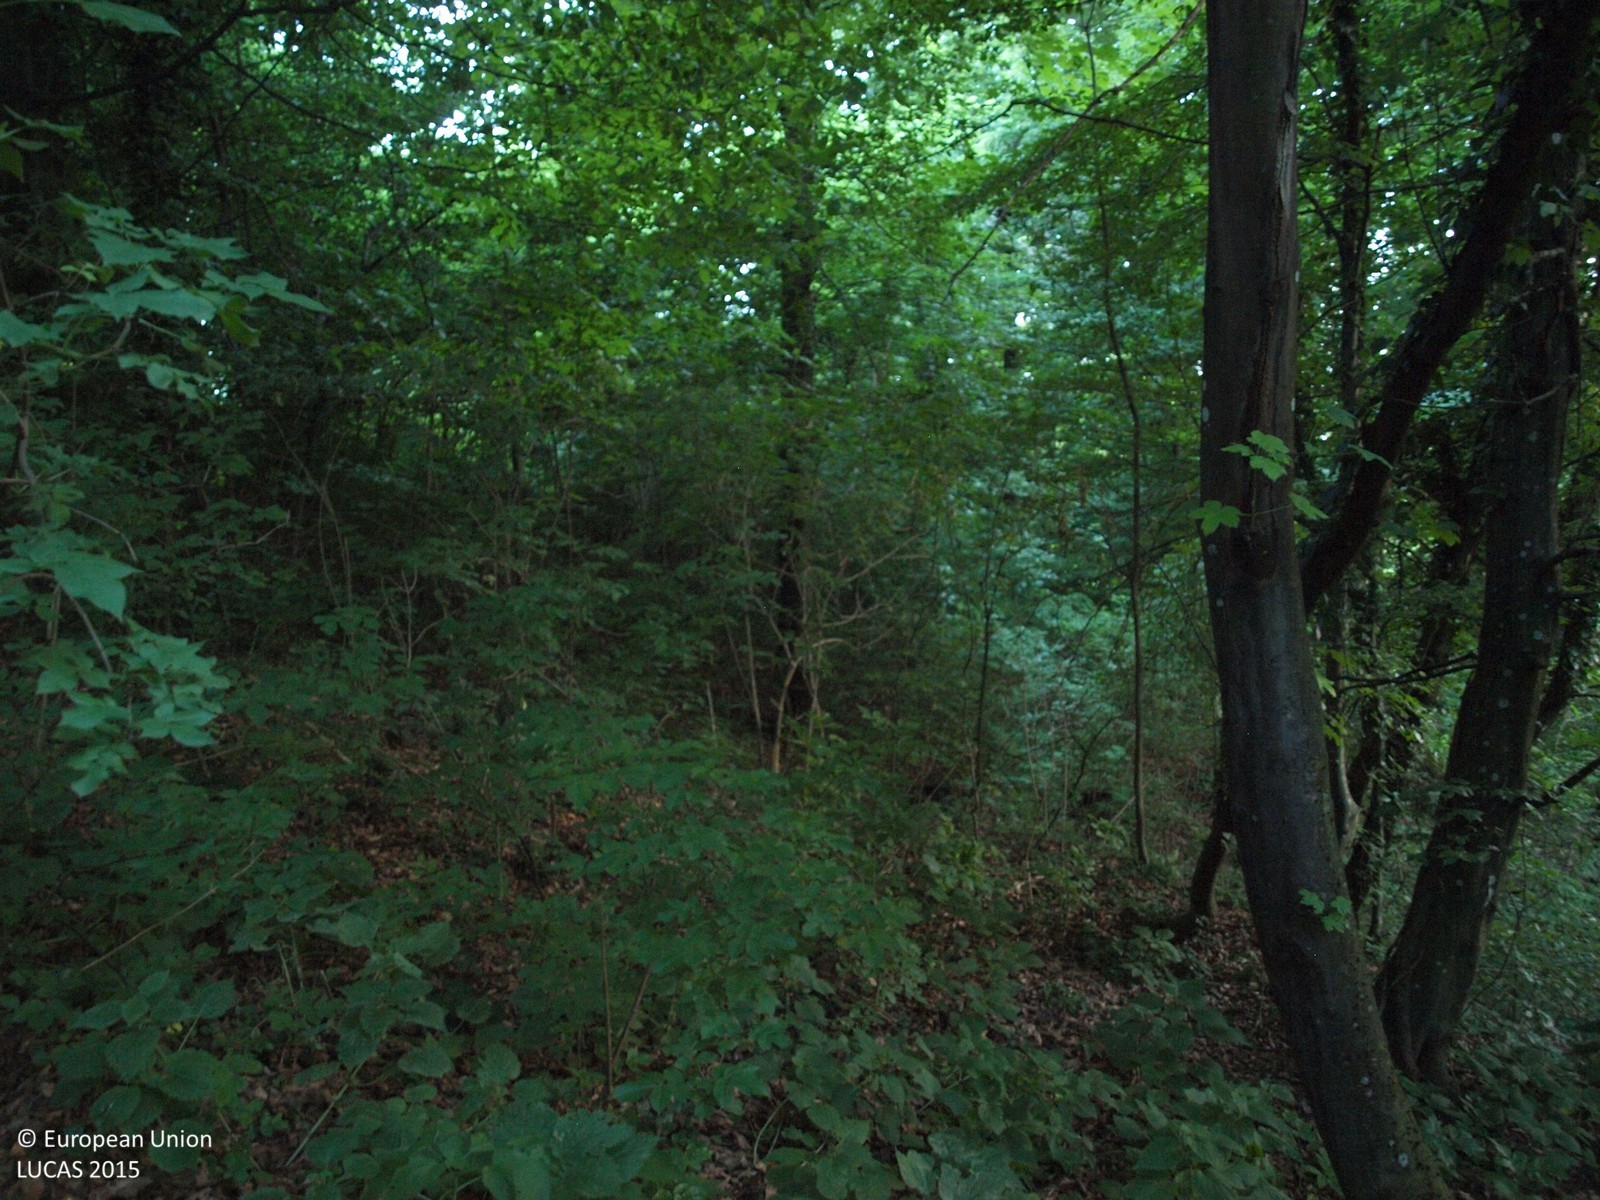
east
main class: Woodland
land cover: Broadleaved woodland
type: mesophytic deciduous forest
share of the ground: > 75 %
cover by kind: broadleaved forest trees 100 %
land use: Forestry
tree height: > 5 m
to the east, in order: Broadleaved woodland; Vineyards; Spontaneously vegetated surfaces; Vineyards; Grassland without tree/shrub cover; Broadleaved woodland; Tracks; Broadleaved woodland; Paved roads, cycling and walking lanes; Broadleaved woodland
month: June
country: HR
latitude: 46.0162
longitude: 15.7457
